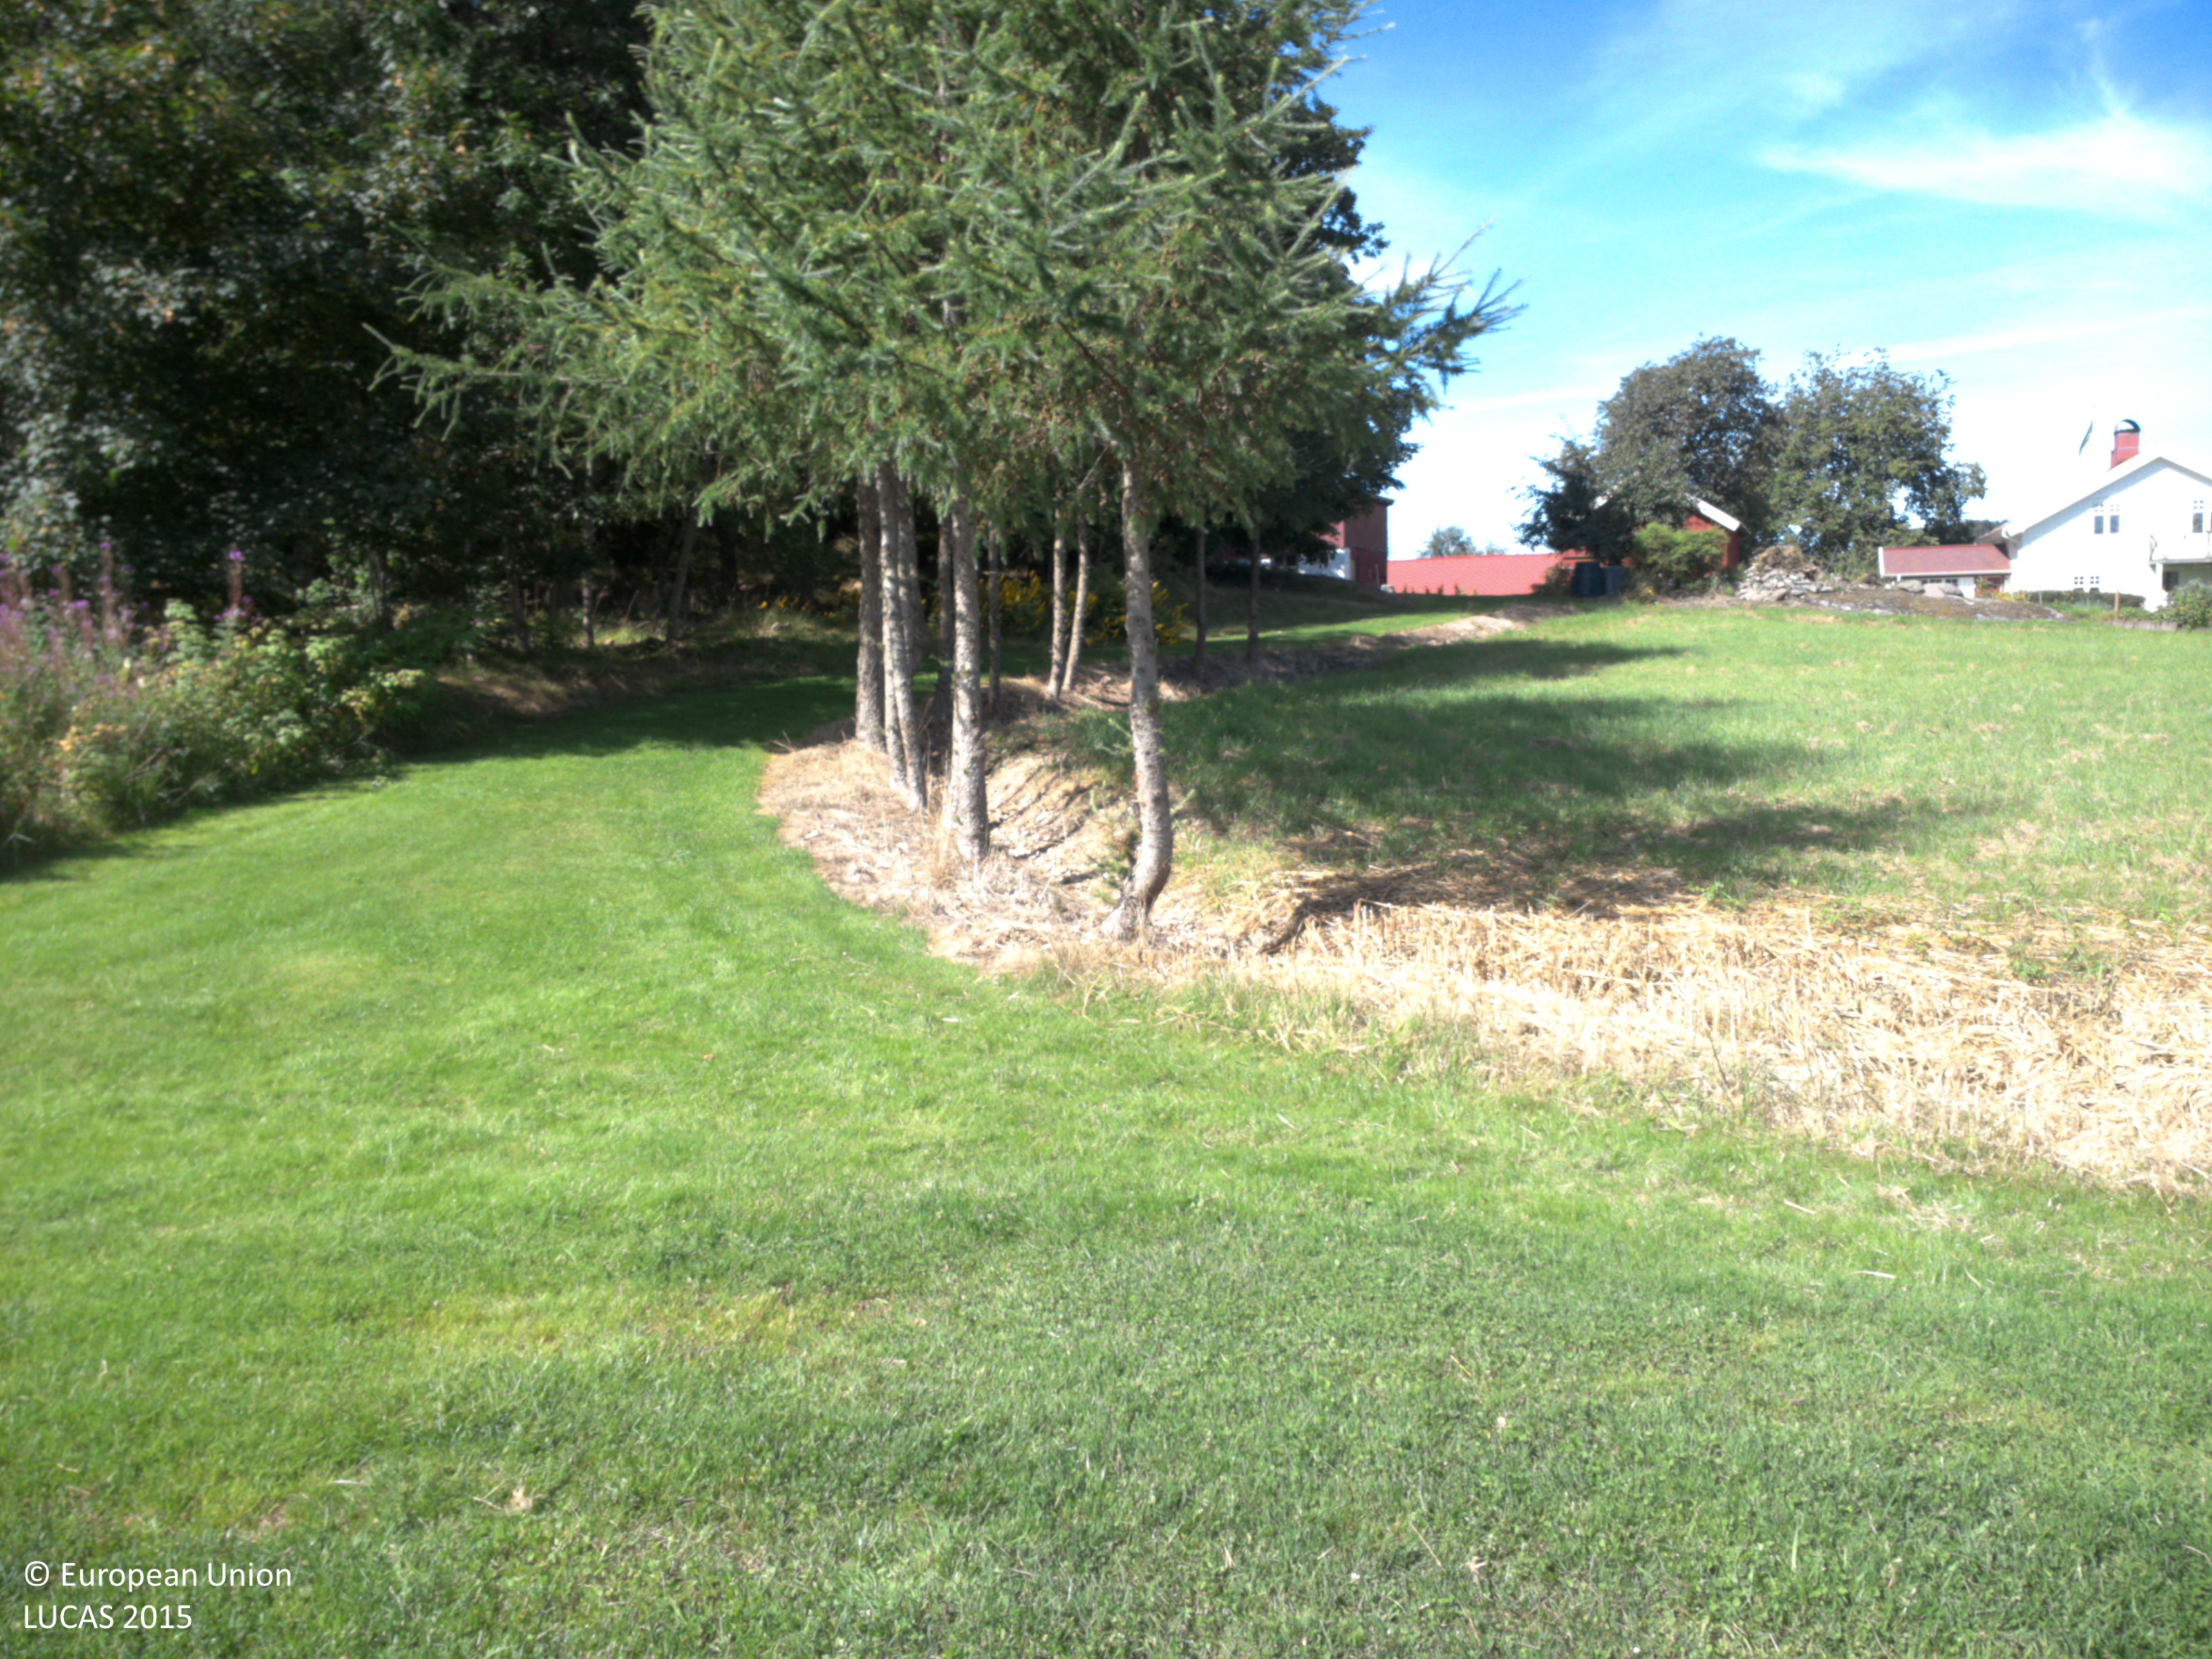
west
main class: Grassland
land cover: Spontaneously vegetated surfaces
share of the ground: > 75 %
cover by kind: herbaceous plants 100 %
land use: Agriculture (excluding fallow land and kitchen gardens)
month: August
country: SE
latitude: 58.0382
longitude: 12.2825
